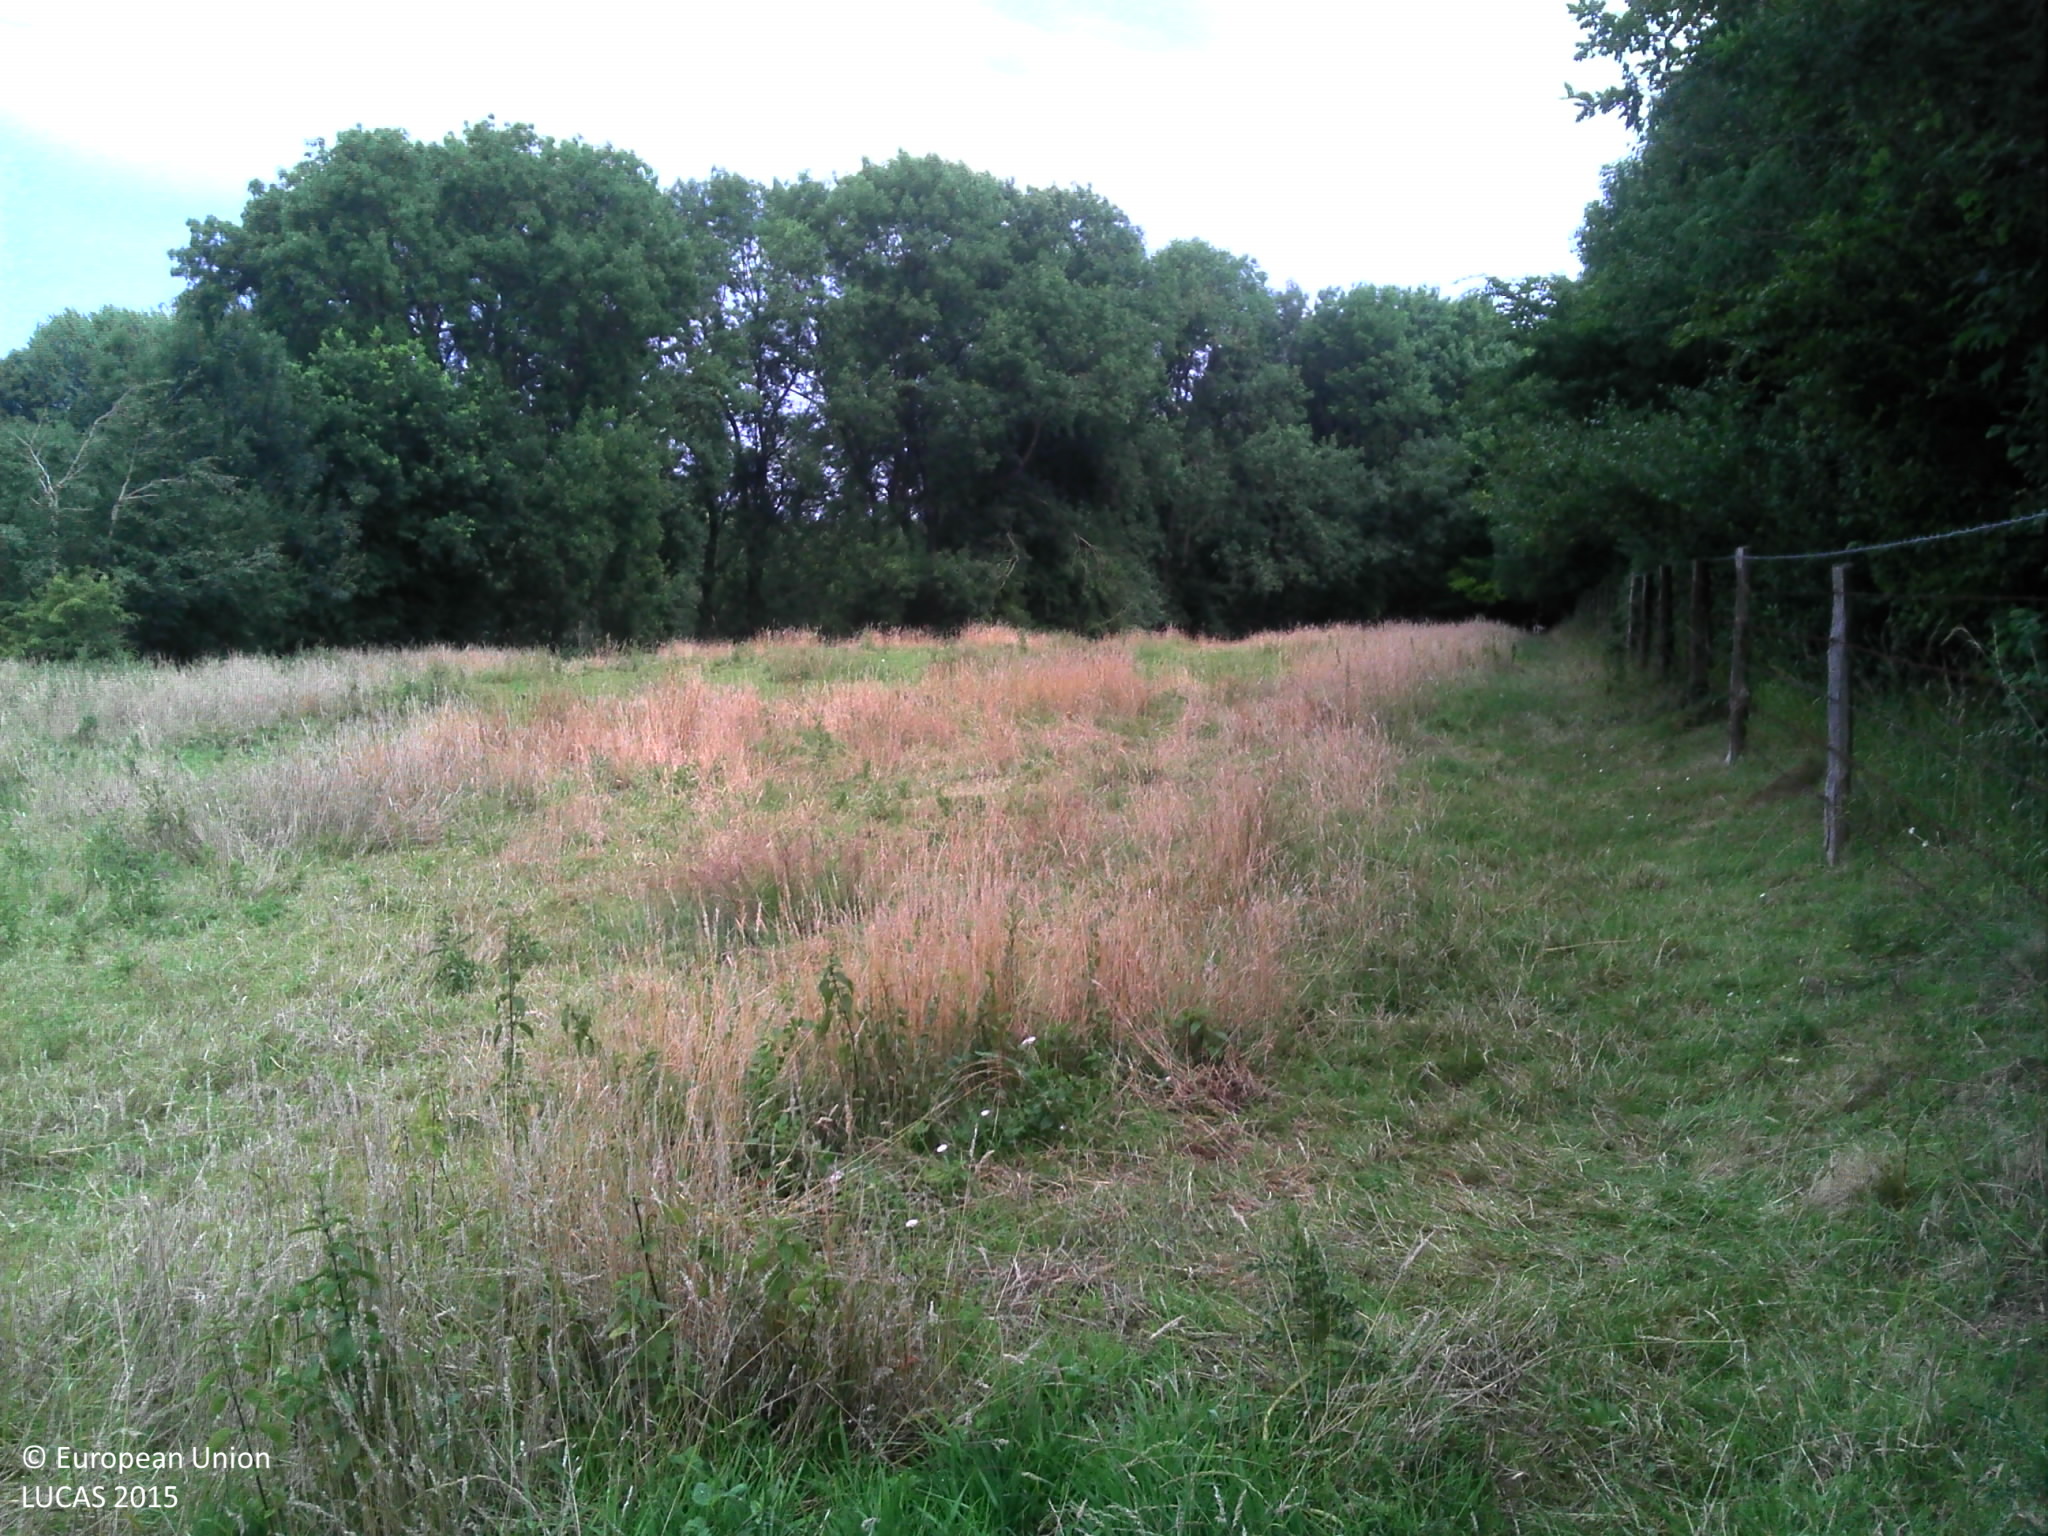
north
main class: Grassland
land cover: Grassland without tree/shrub cover
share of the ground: > 75 %
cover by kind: herbaceous plants 100 %
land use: Agriculture (excluding fallow land and kitchen gardens)
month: July
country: FR
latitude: 50.1332
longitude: 2.1933
